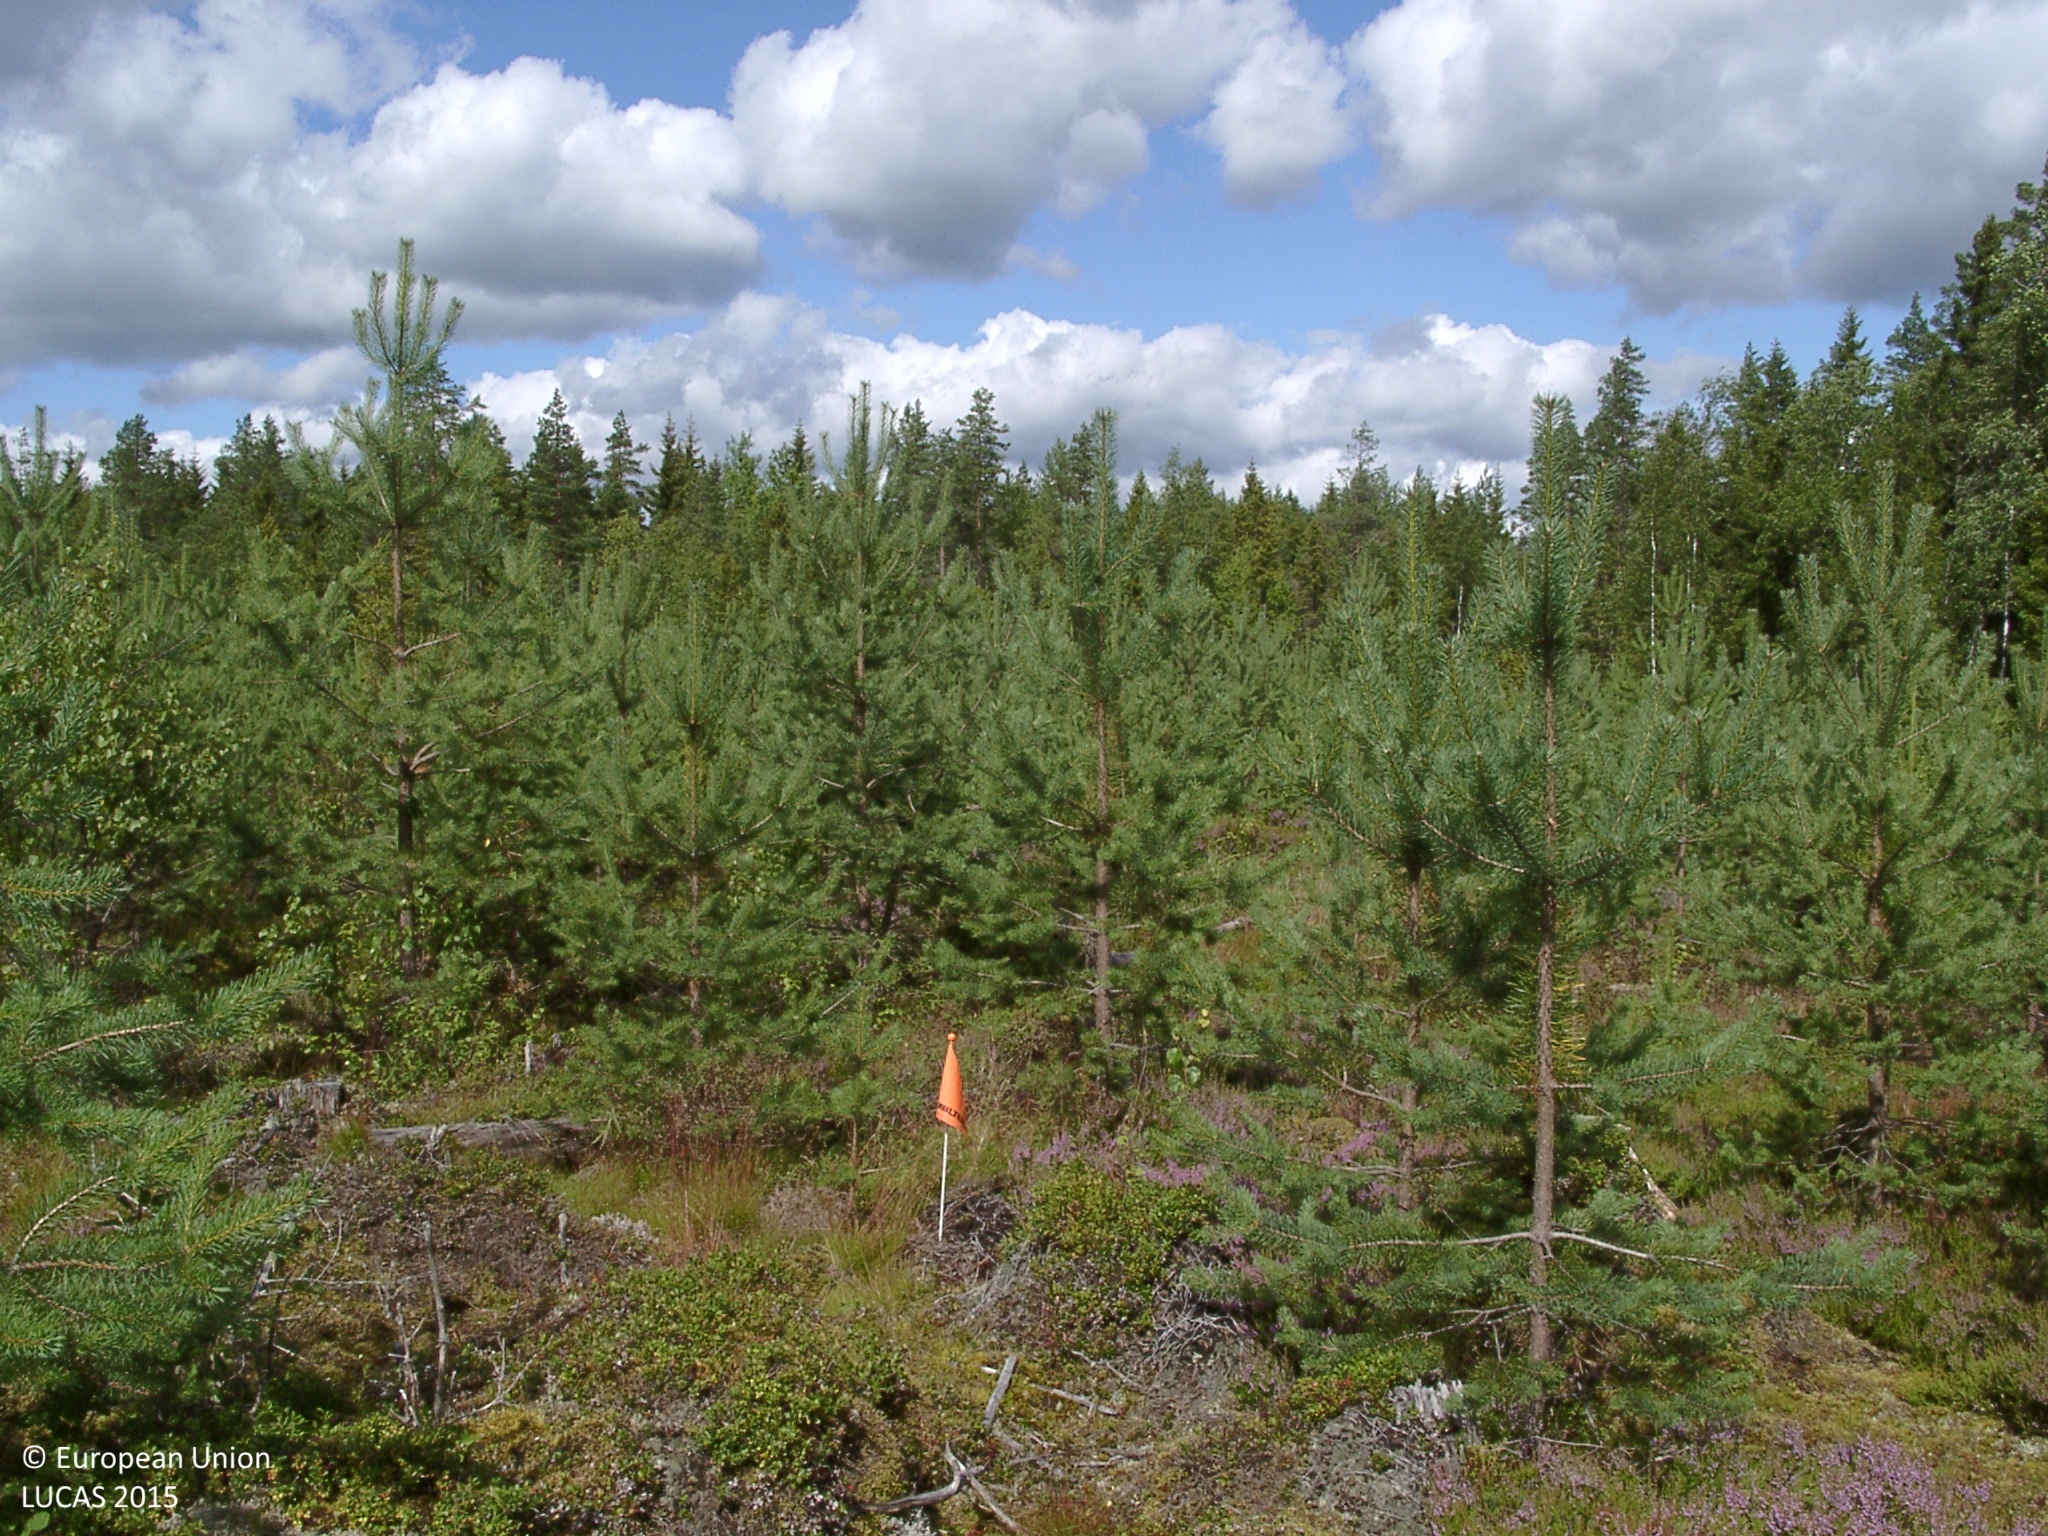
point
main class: Woodland
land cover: Pine dominated coniferous woodland
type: boreal forest
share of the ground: 25 - 50 %
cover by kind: coniferous forest trees 40 %, shrubs 35 %, lichens and mosses 15 %, broadleaved forest trees 5 %, herbaceous plants 5 %
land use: Forestry
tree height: < 5 m
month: August
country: FI
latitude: 62.9996
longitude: 24.5983
